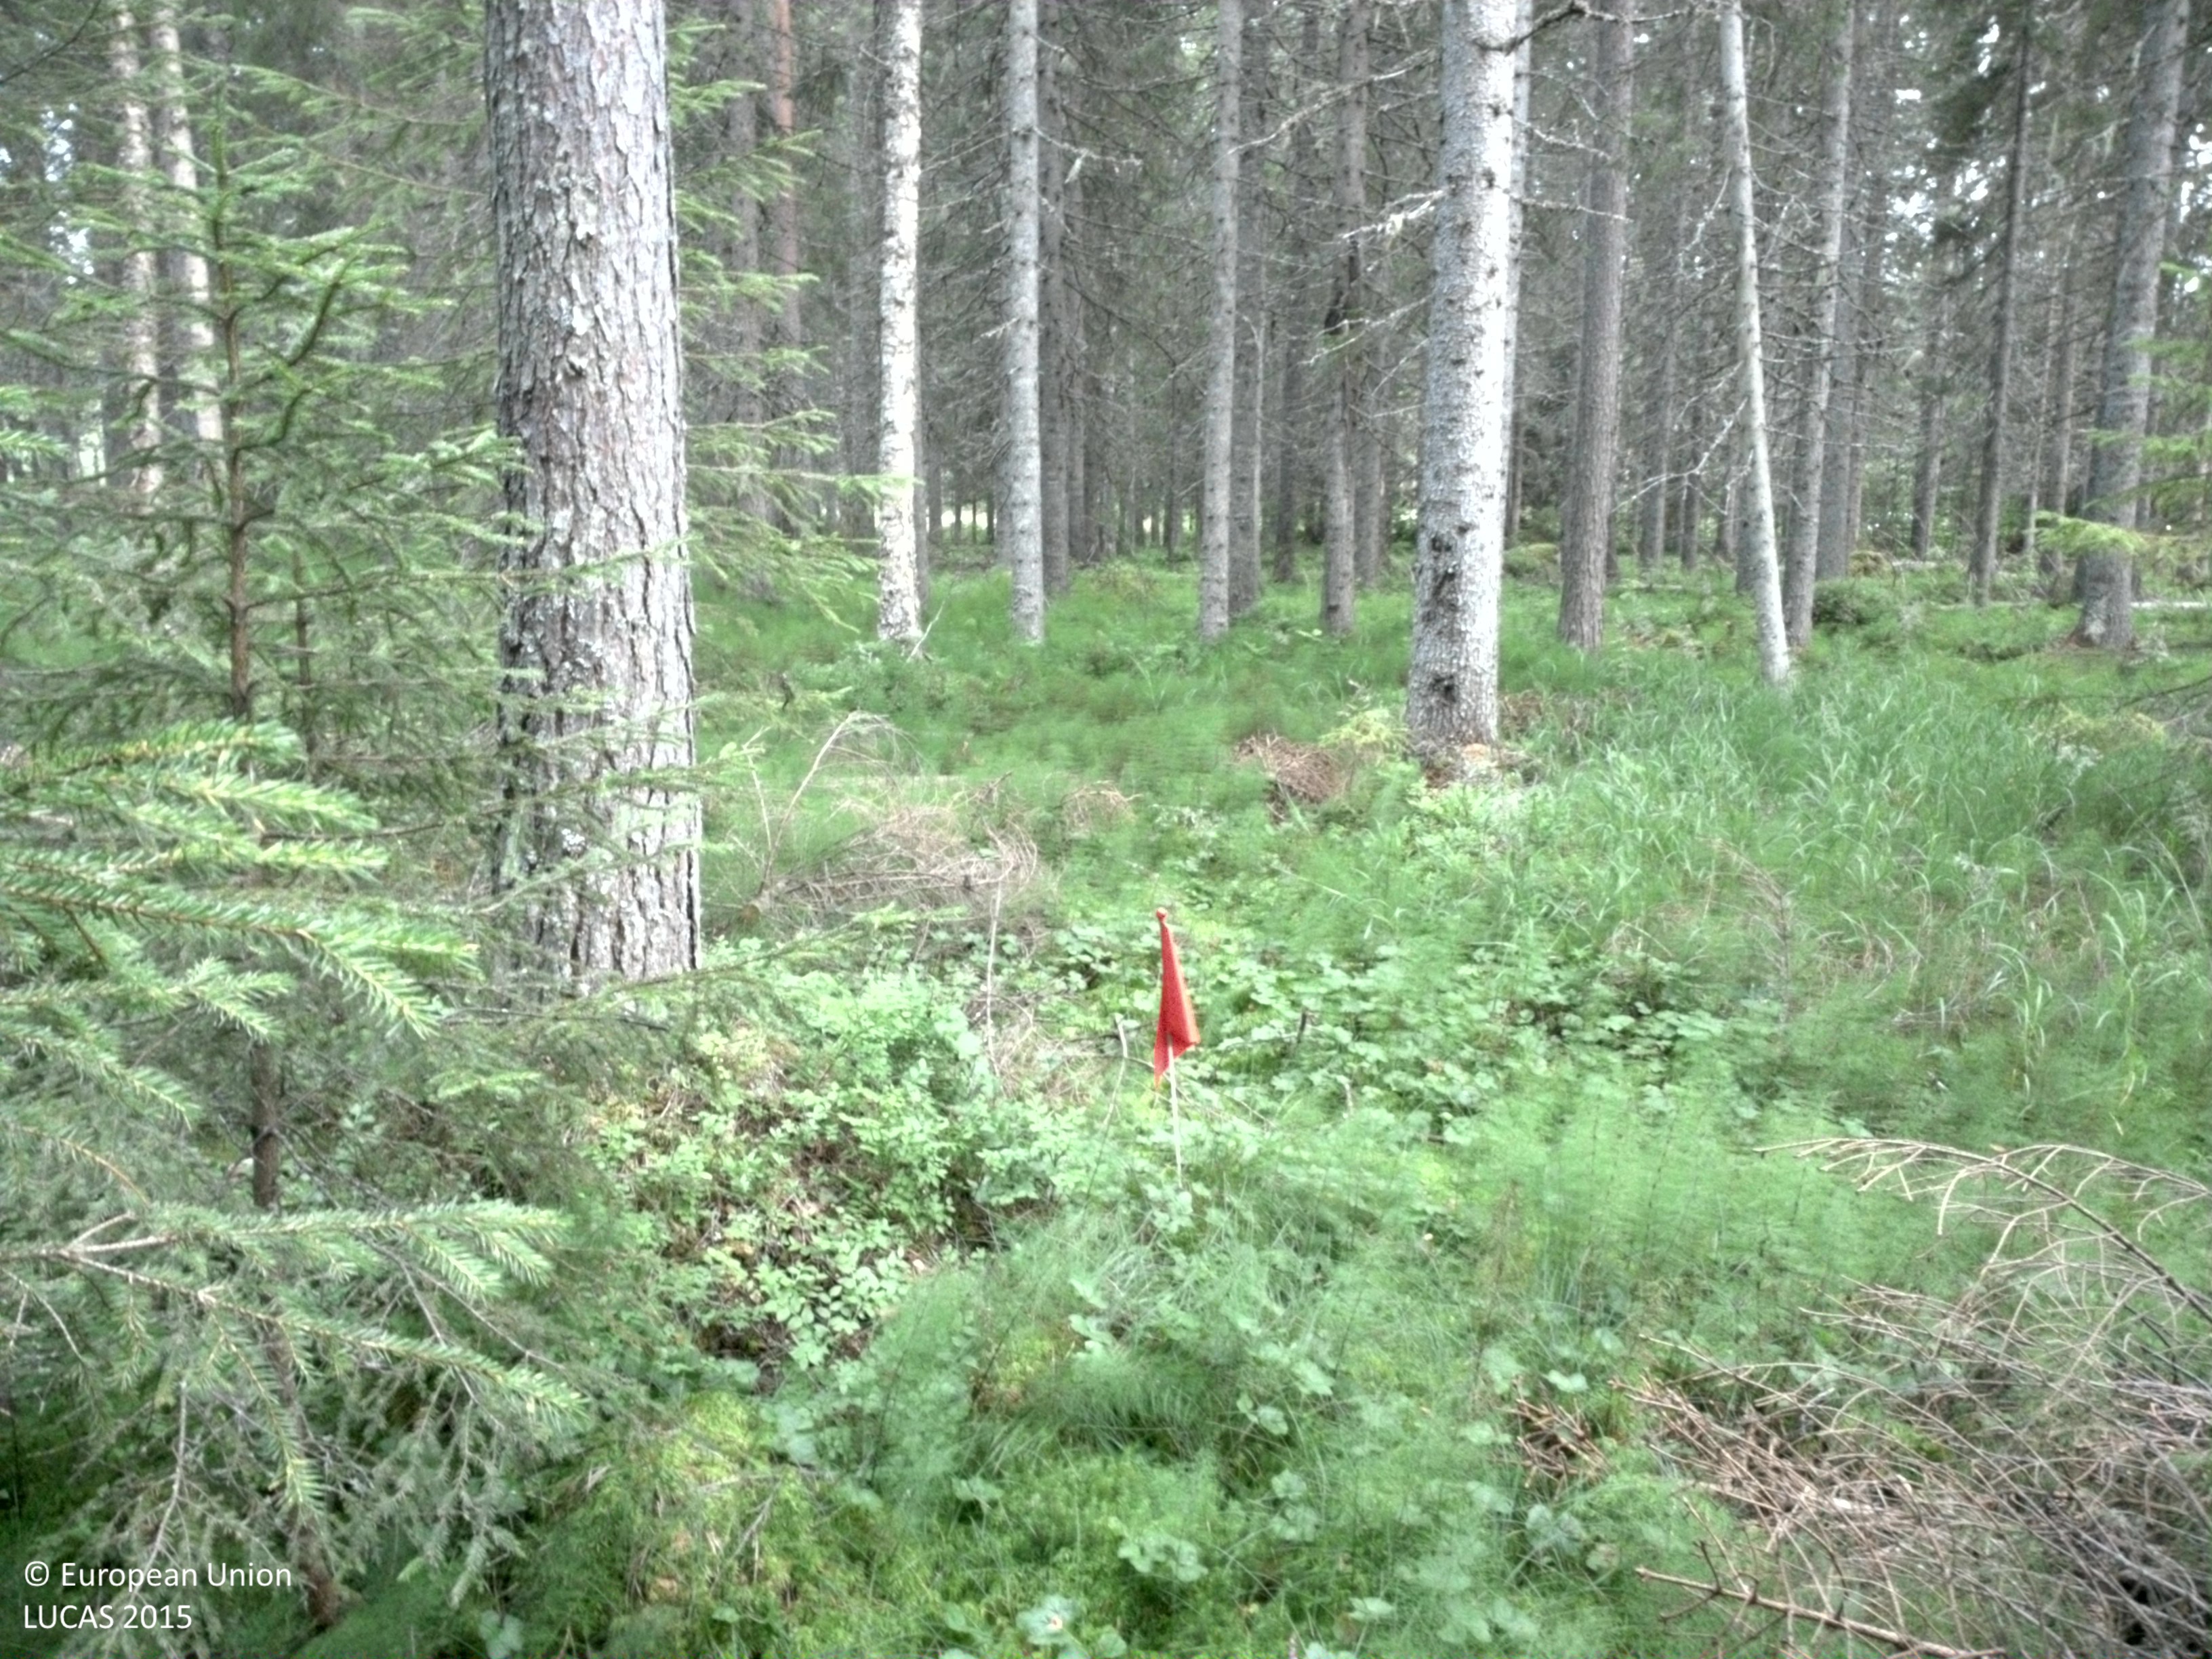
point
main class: Woodland
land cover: Spruce dominated mixed woodland
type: boreal forest
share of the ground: 50 - 75 %
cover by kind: coniferous forest trees 45 %, shrubs 25 %, broadleaved forest trees 15 %, herbaceous plants 15 %
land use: Forestry
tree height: > 5 m
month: August
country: SE
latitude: 64.6731
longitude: 20.7249
